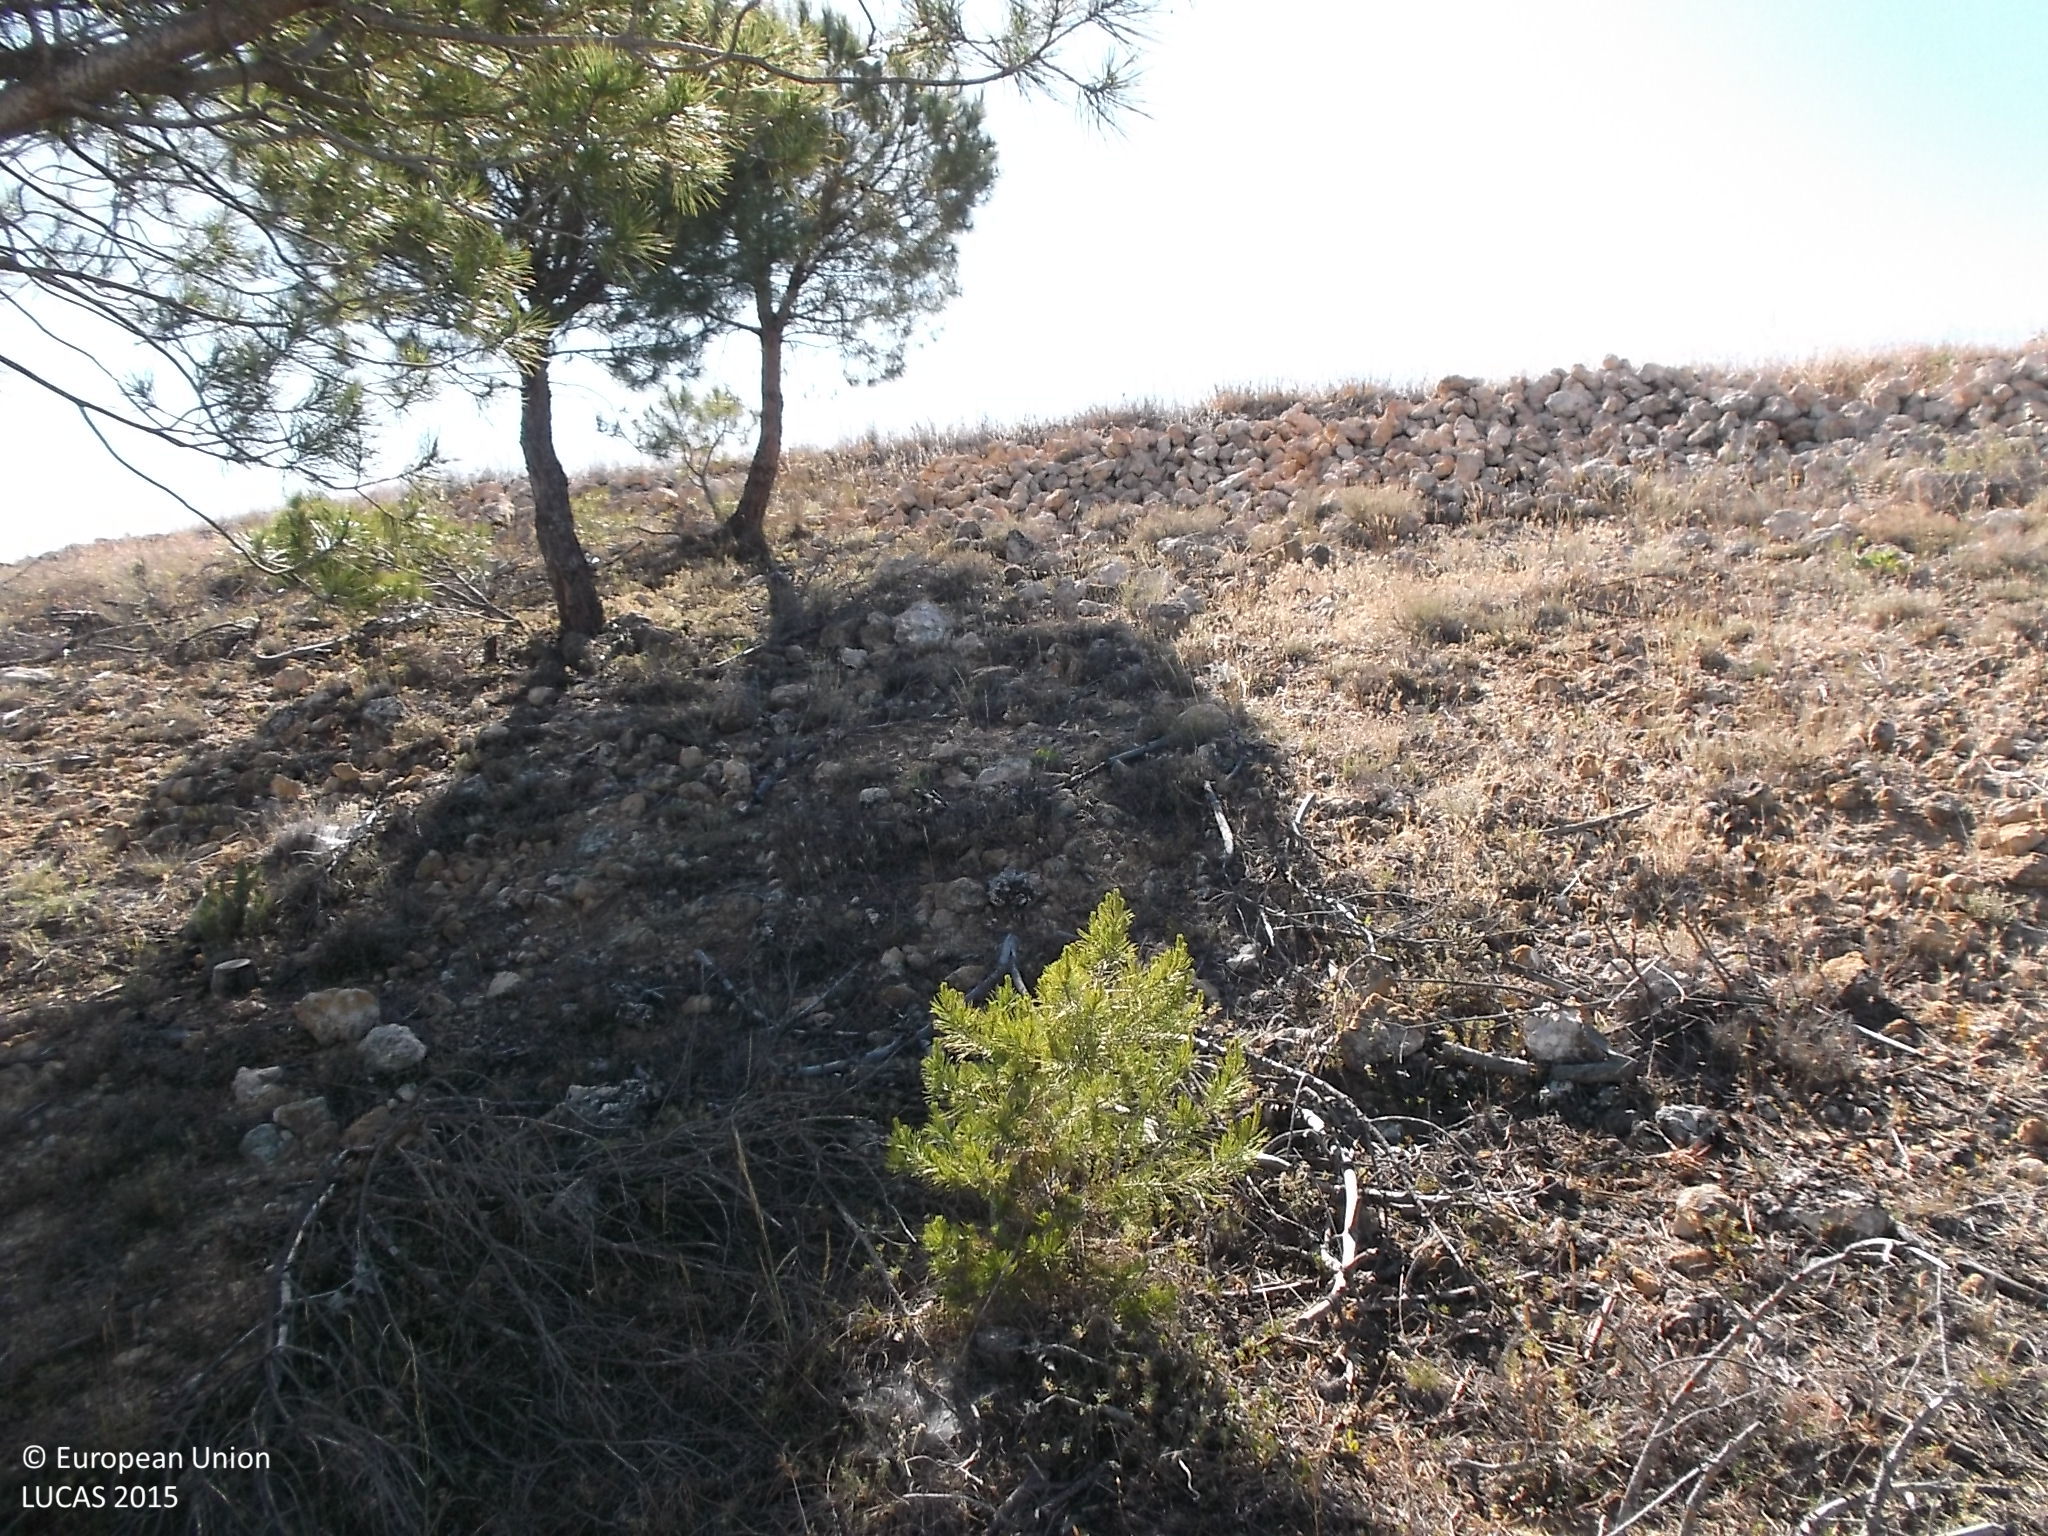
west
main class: Woodland
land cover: Pine dominated coniferous woodland
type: coniferous forest of the mediterranean region
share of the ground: 25 - 50 %
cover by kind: herbaceous plants 65 %, coniferous forest trees 35 %
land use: Forestry
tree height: < 5 m
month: June
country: ES
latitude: 41.3175
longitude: -5.3064
